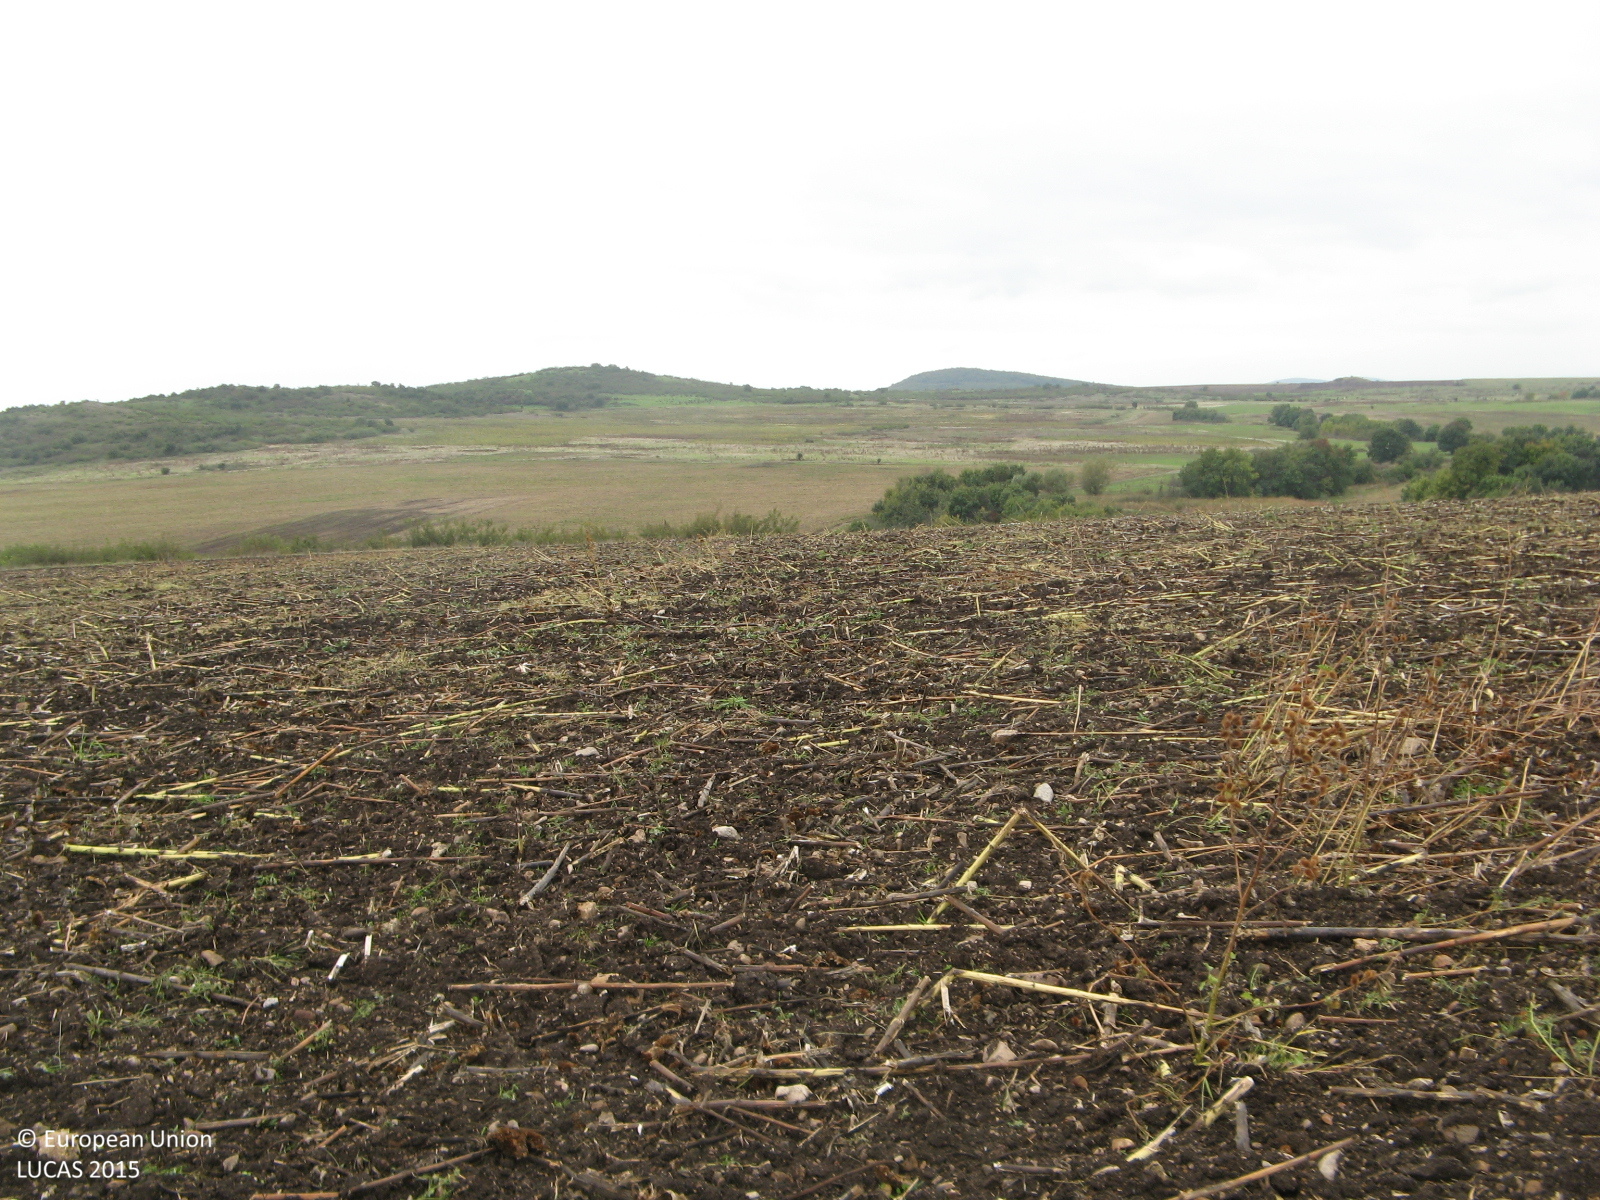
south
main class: Cropland
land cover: Sunflower
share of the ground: < 10 %
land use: Agriculture (excluding fallow land and kitchen gardens)
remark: Harvested field
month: October
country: BG
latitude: 41.9853
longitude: 25.3782
